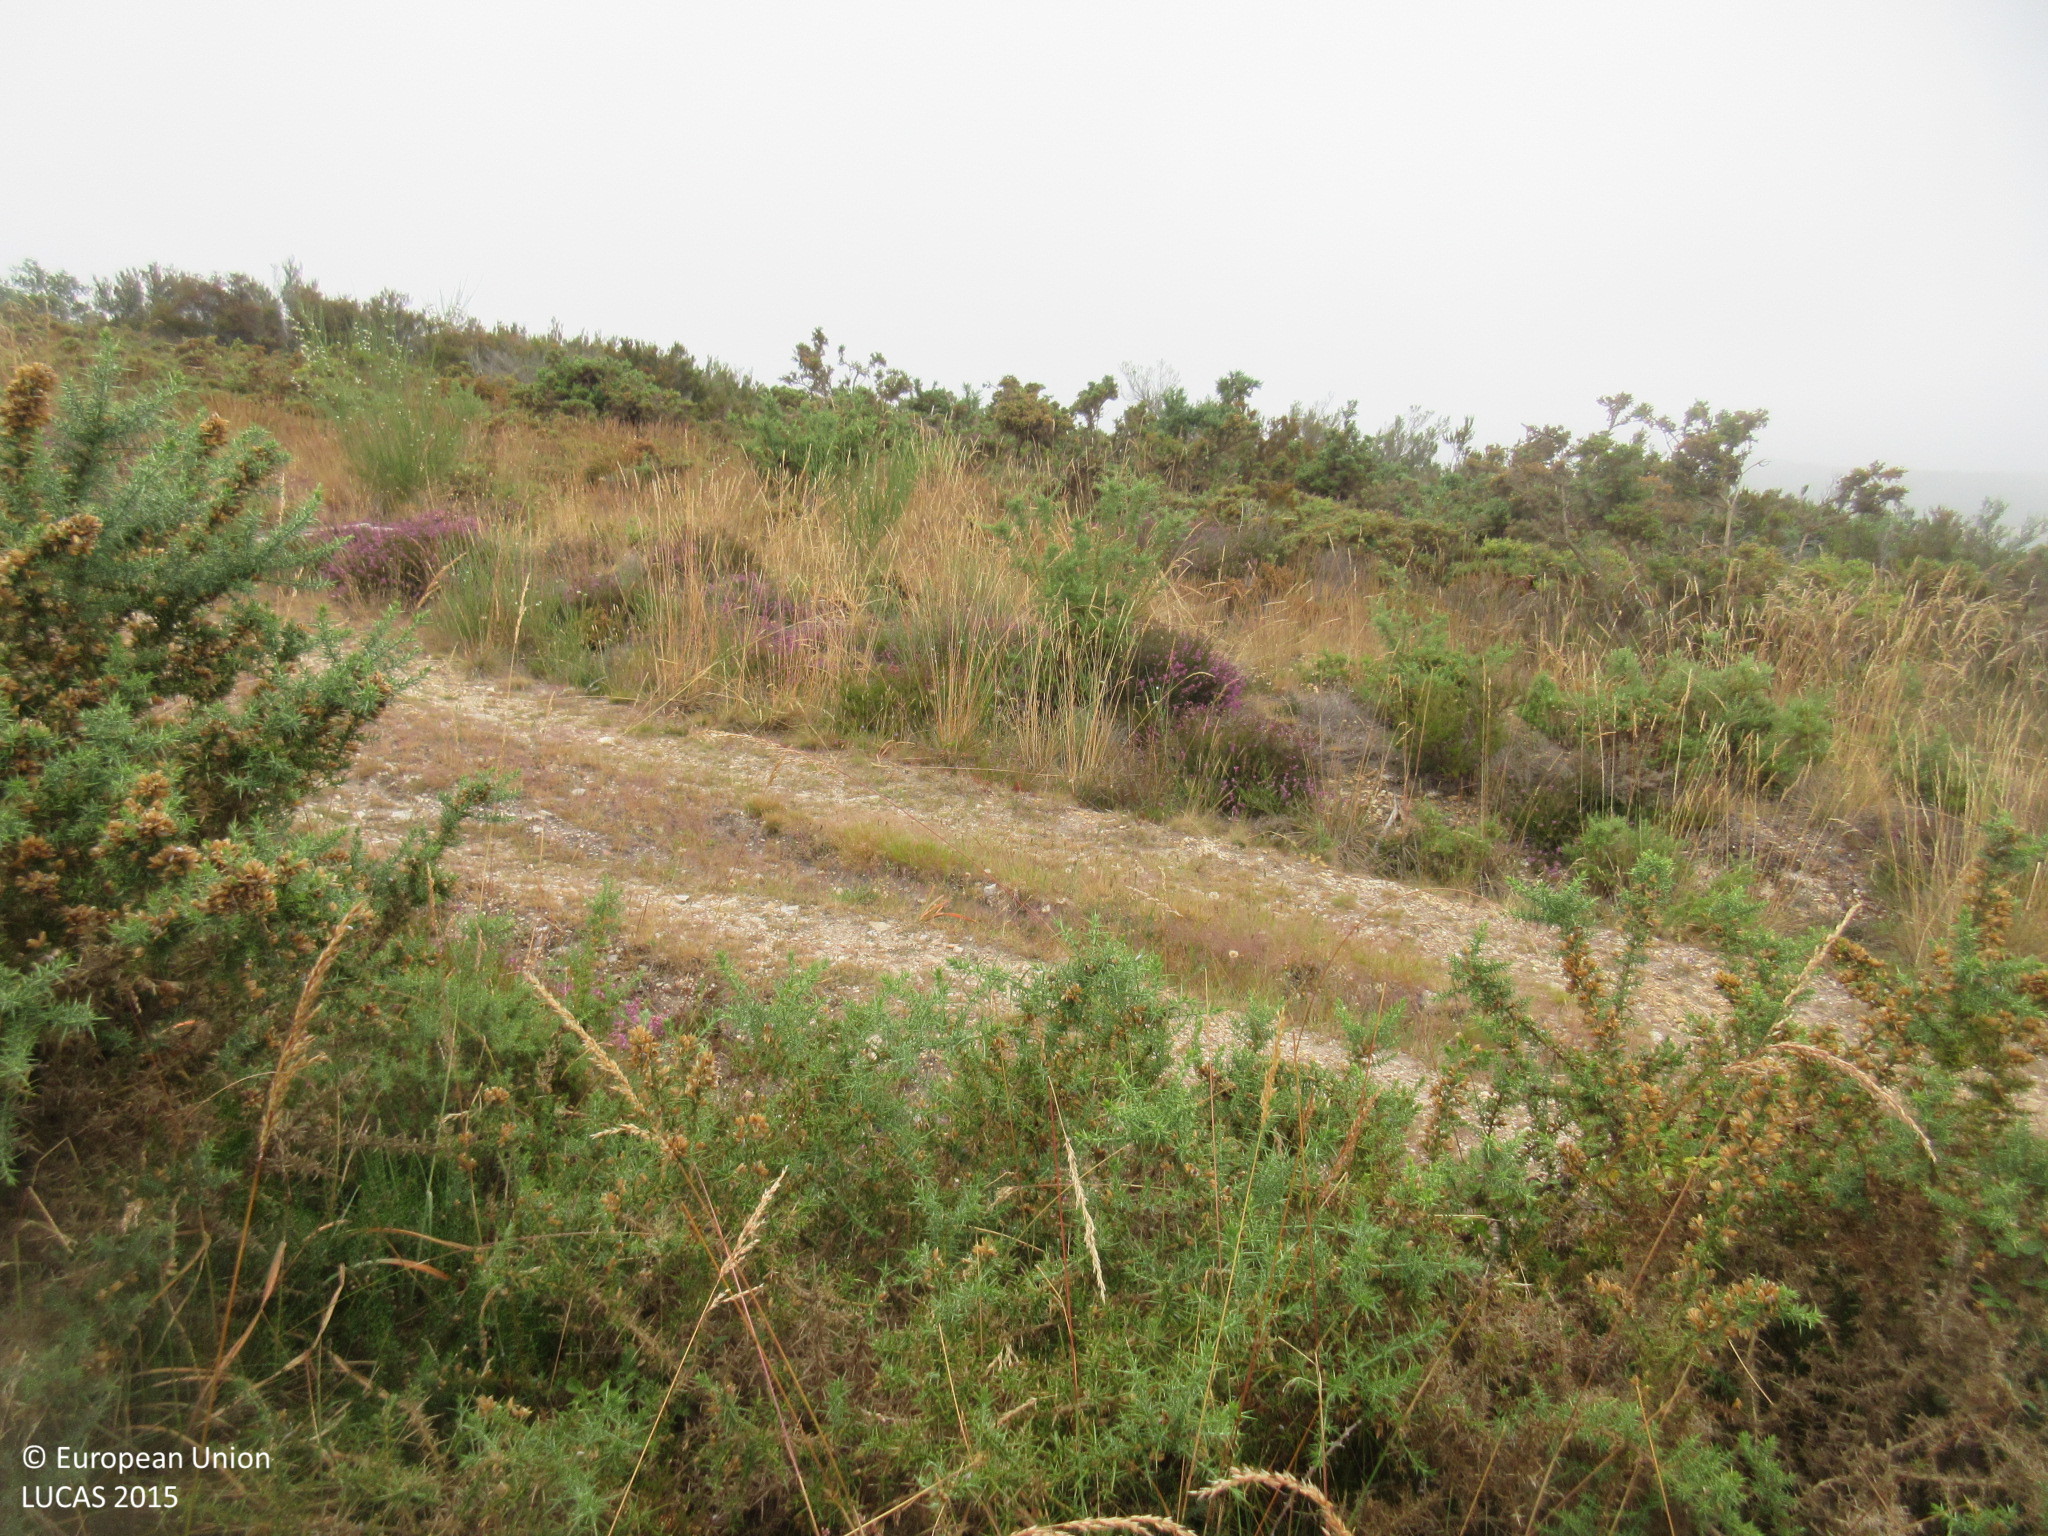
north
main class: Shrubland
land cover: Shrubland with sparse tree cover
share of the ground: > 75 %
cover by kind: shrubs 95 %, broadleaved forest trees 5 %
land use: Semi-natural and natural areas not in use
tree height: > 5 m
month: June
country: ES
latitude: 42.8959
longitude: -7.1228
